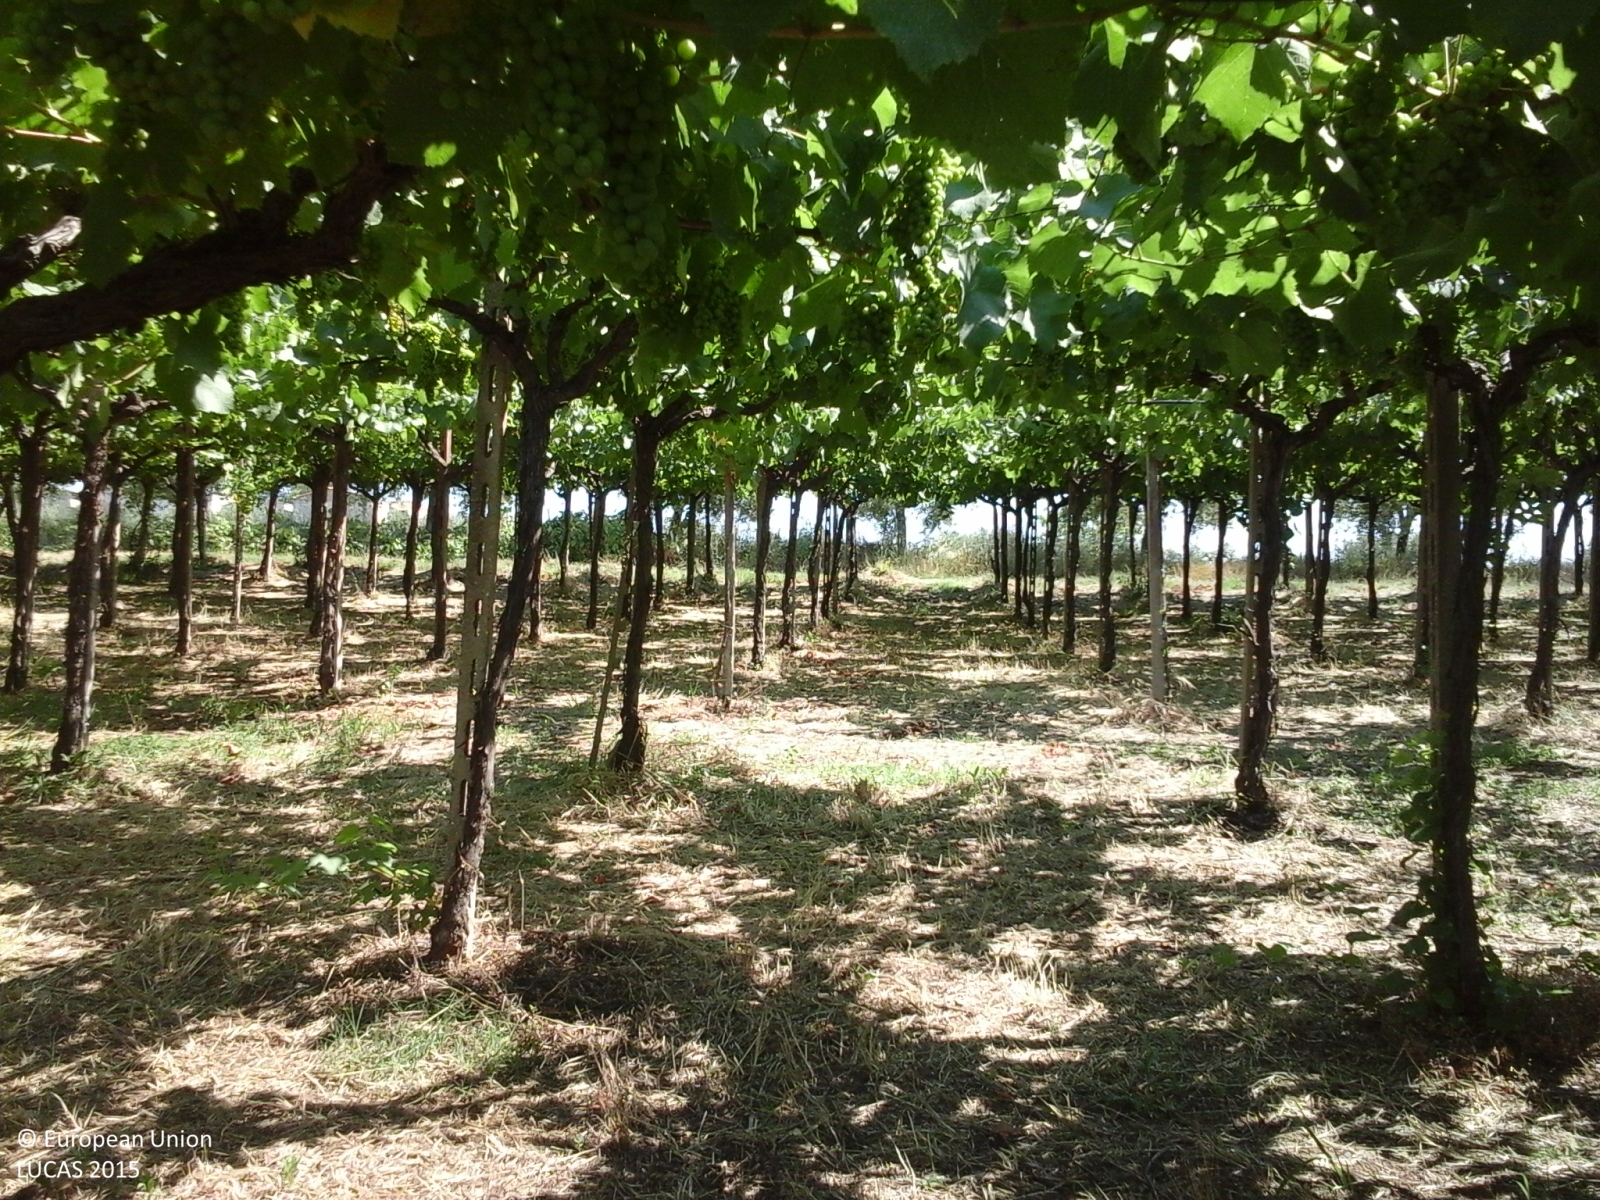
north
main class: Cropland
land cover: Vineyards
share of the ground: 25 - 50 %
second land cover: Spontaneously vegetated surfaces
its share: 25 - 50 %
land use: Agriculture (excluding fallow land and kitchen gardens)
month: July
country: IT
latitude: 42.2886
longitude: 14.3649
